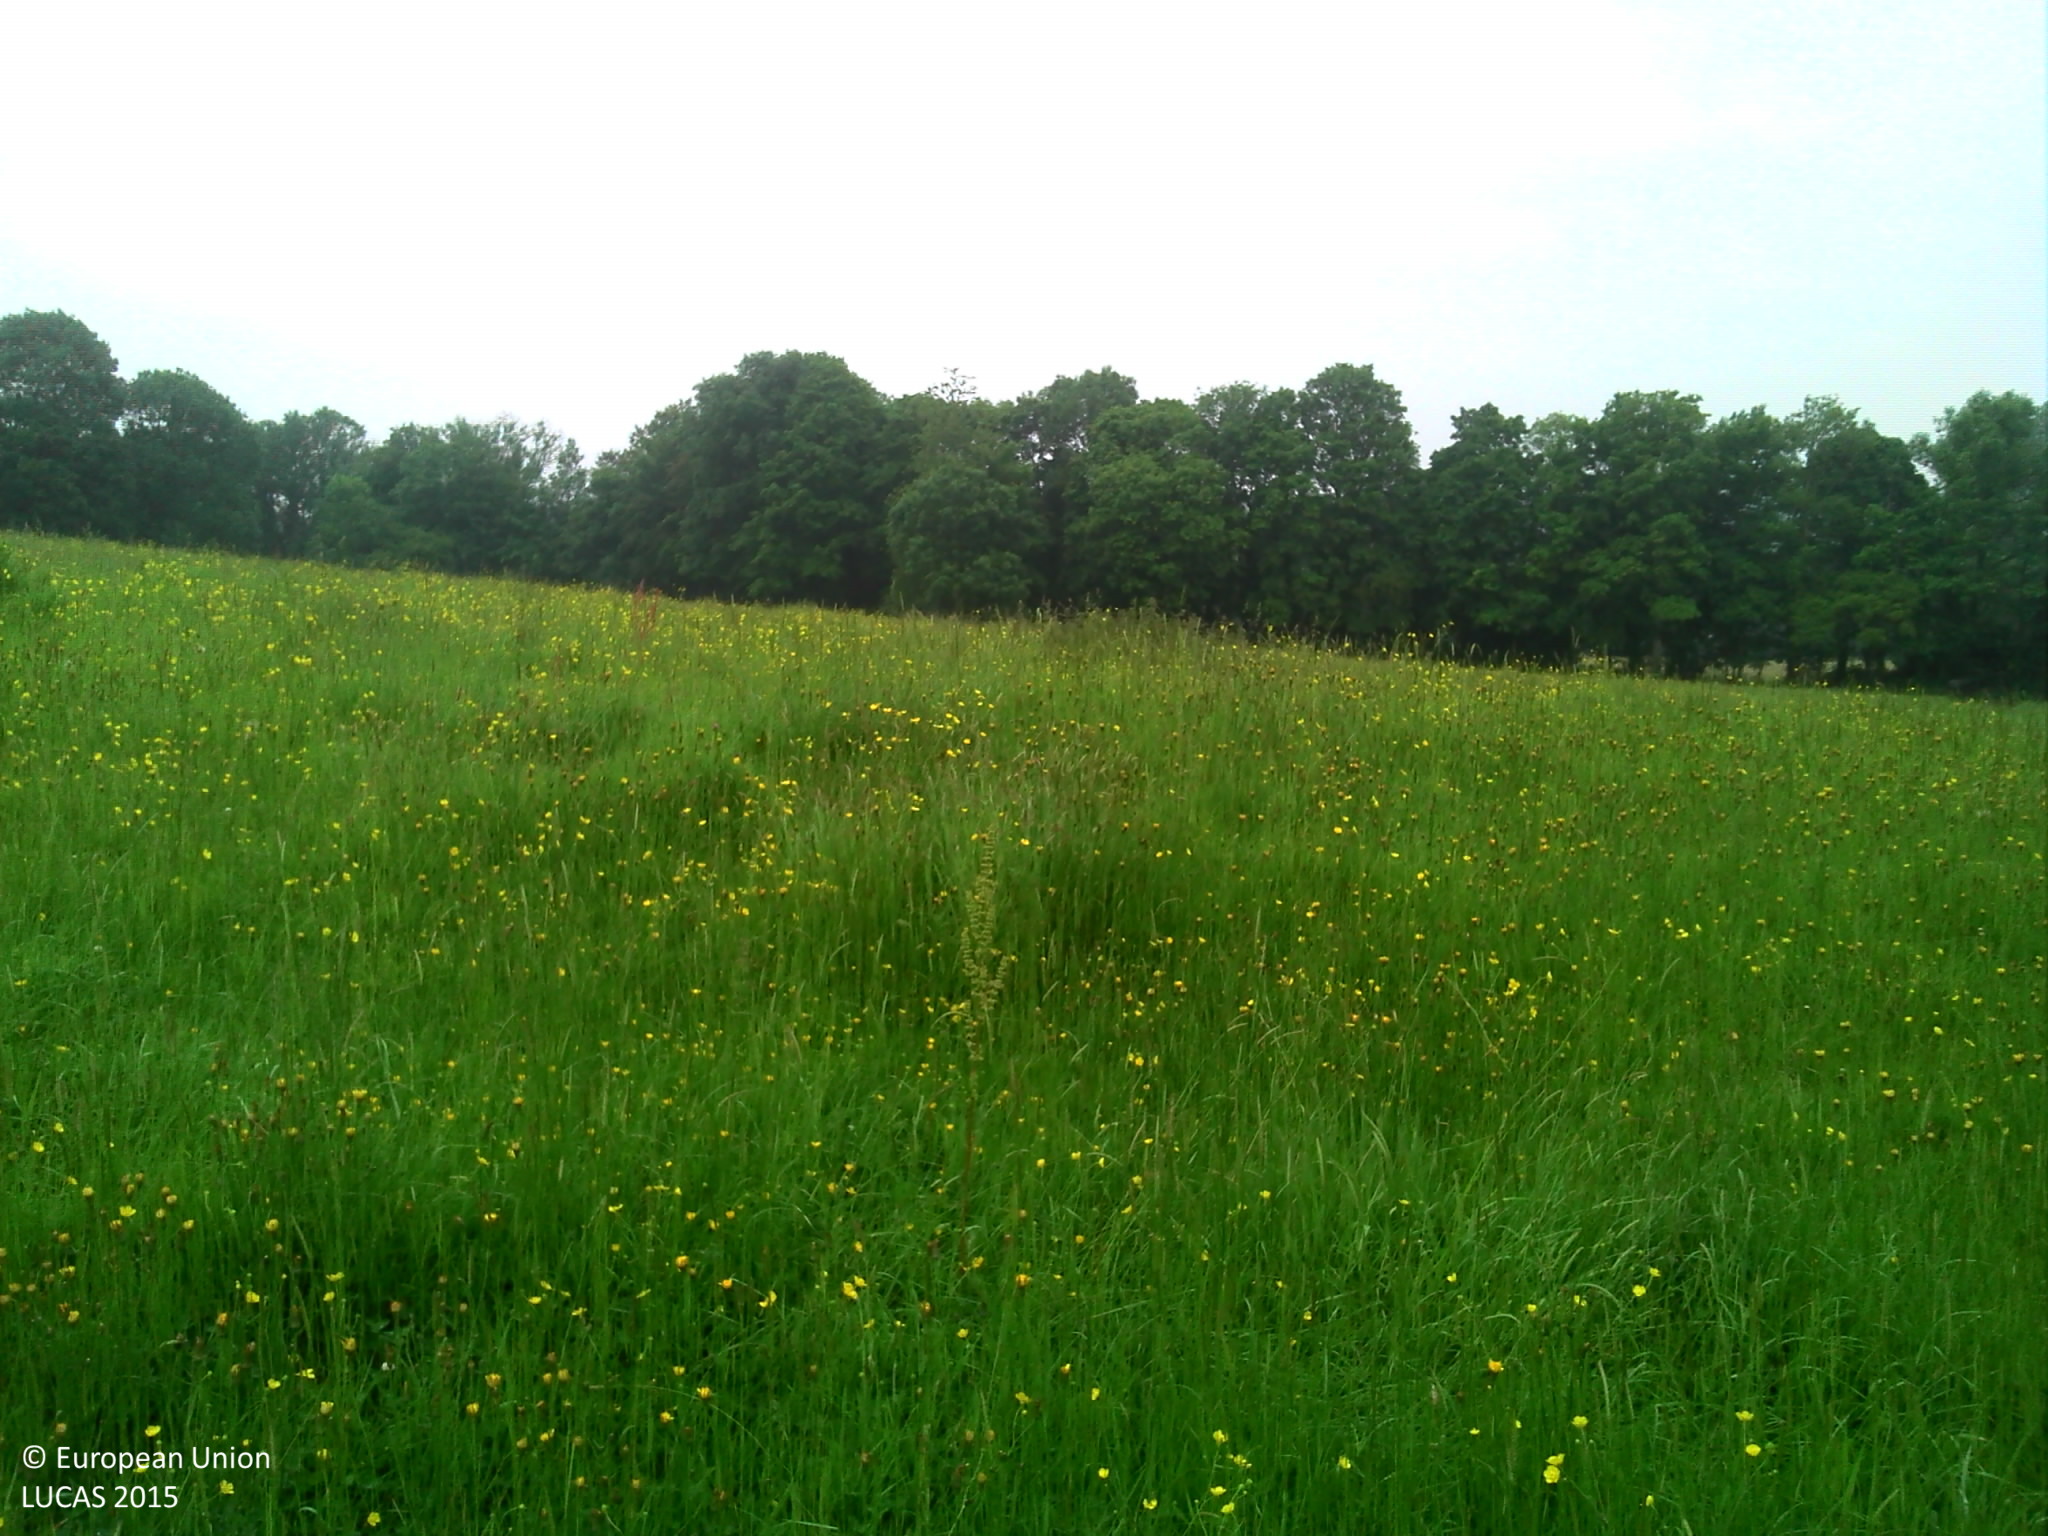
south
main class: Grassland
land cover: Grassland without tree/shrub cover
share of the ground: > 75 %
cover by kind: herbaceous plants 100 %
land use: Agriculture (excluding fallow land and kitchen gardens)
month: June
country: FR
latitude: 49.2549
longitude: 0.0079
